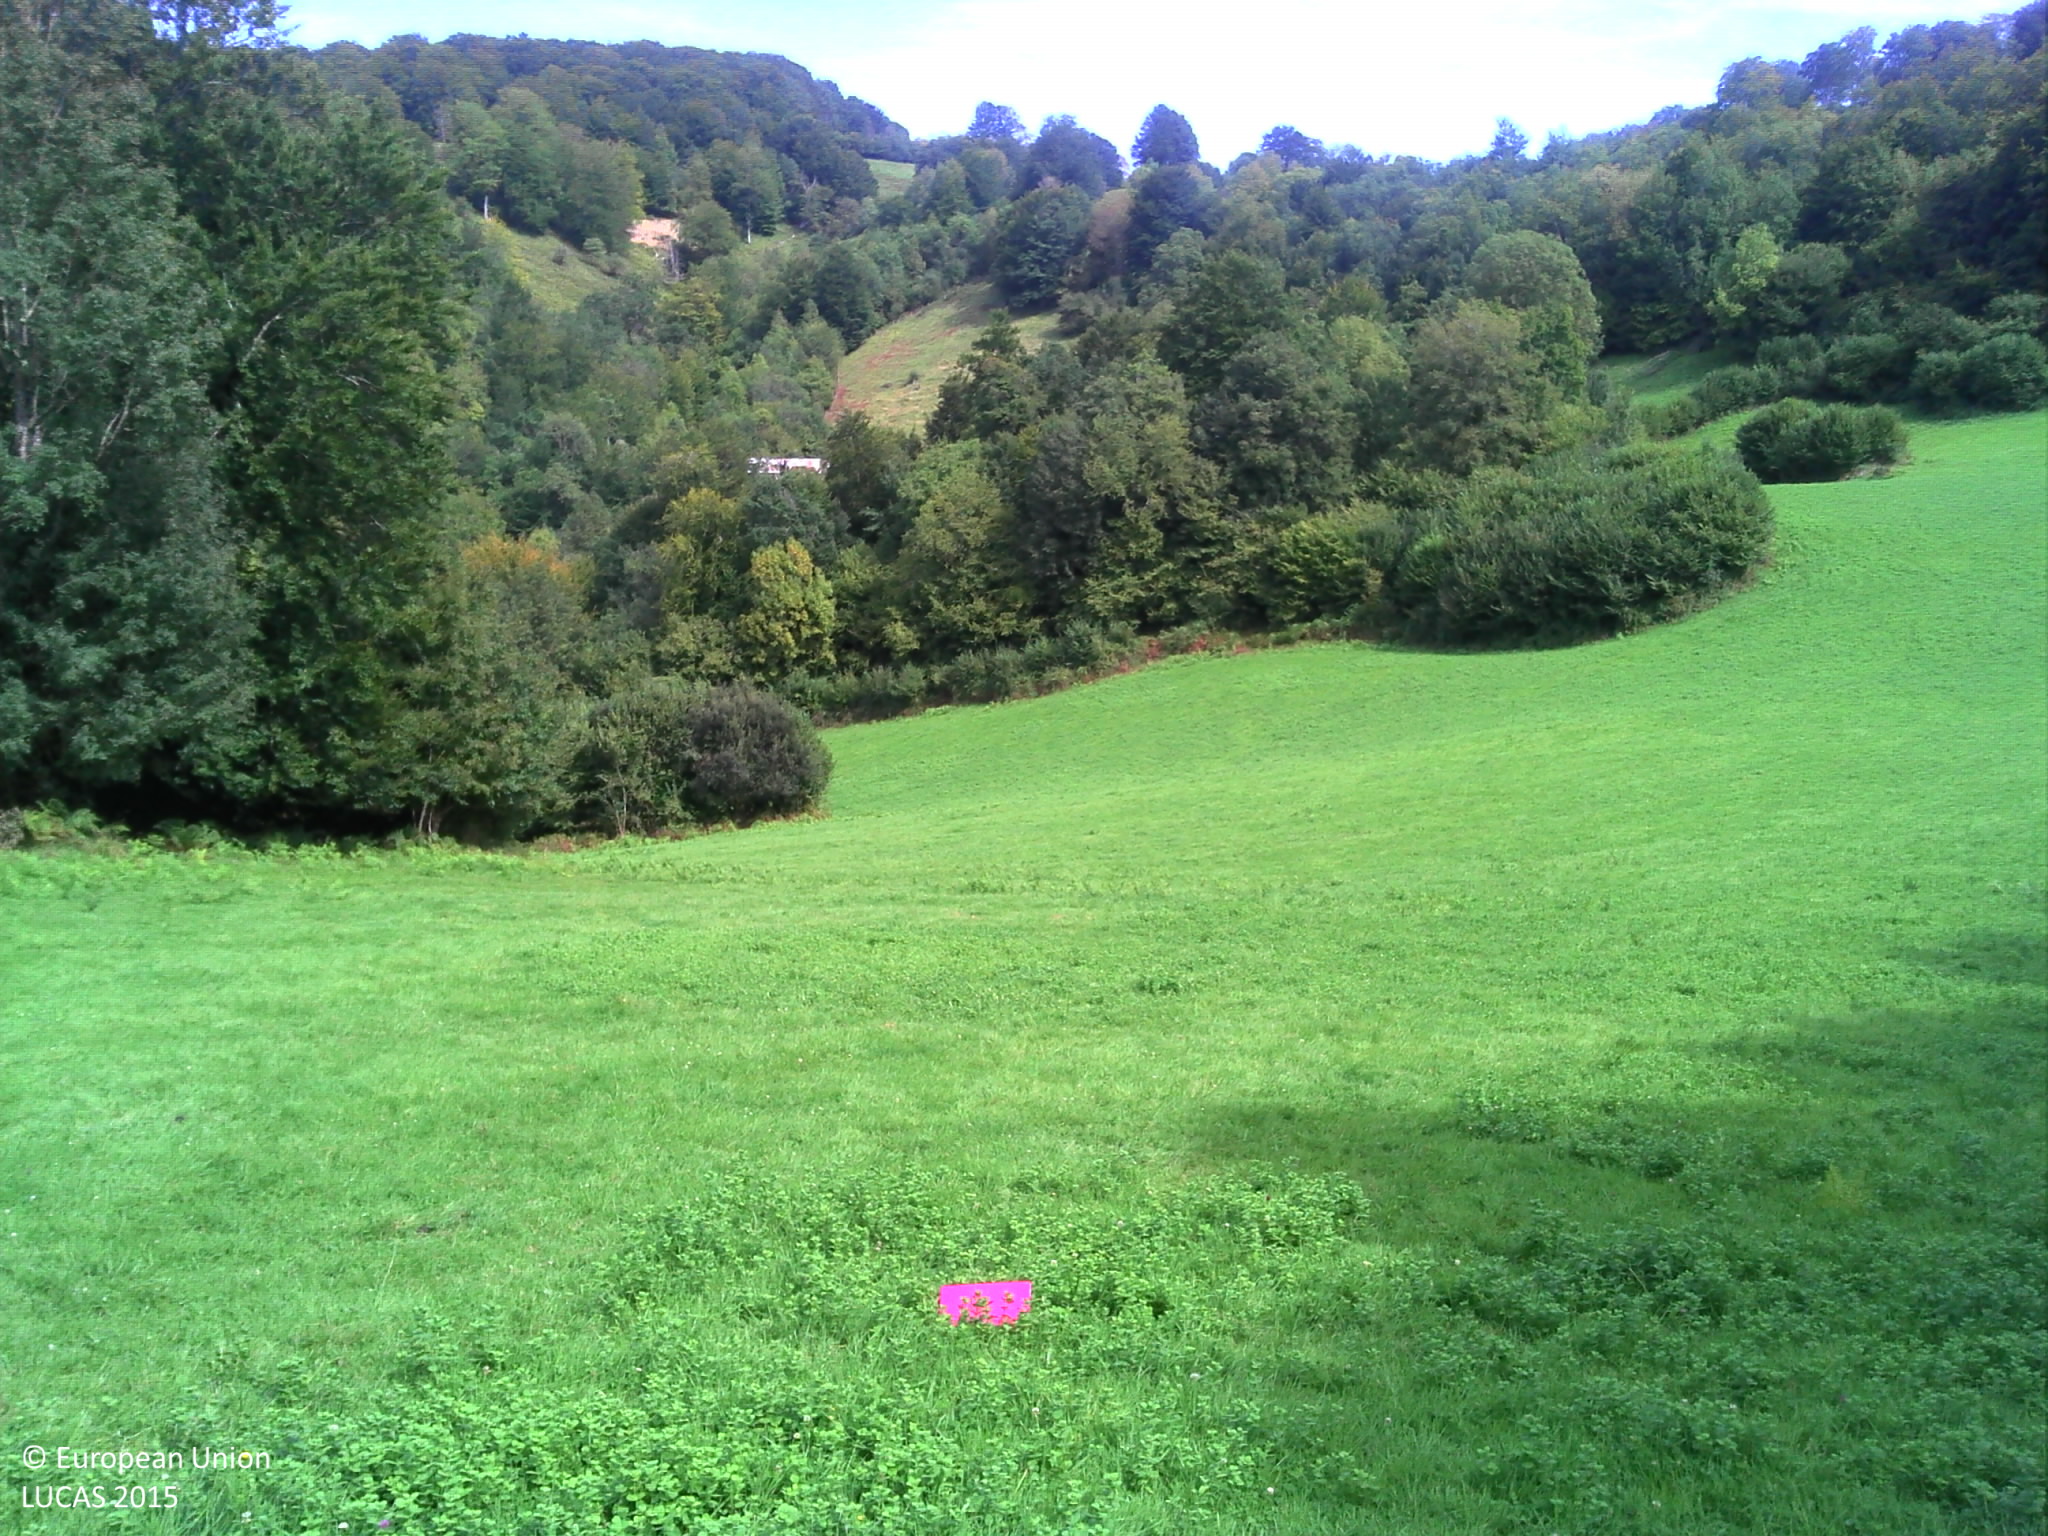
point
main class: Grassland
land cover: Grassland without tree/shrub cover
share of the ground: > 75 %
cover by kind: herbaceous plants 100 %
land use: Agriculture (excluding fallow land and kitchen gardens)
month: September
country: FR
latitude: 43.1615
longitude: -1.0189
